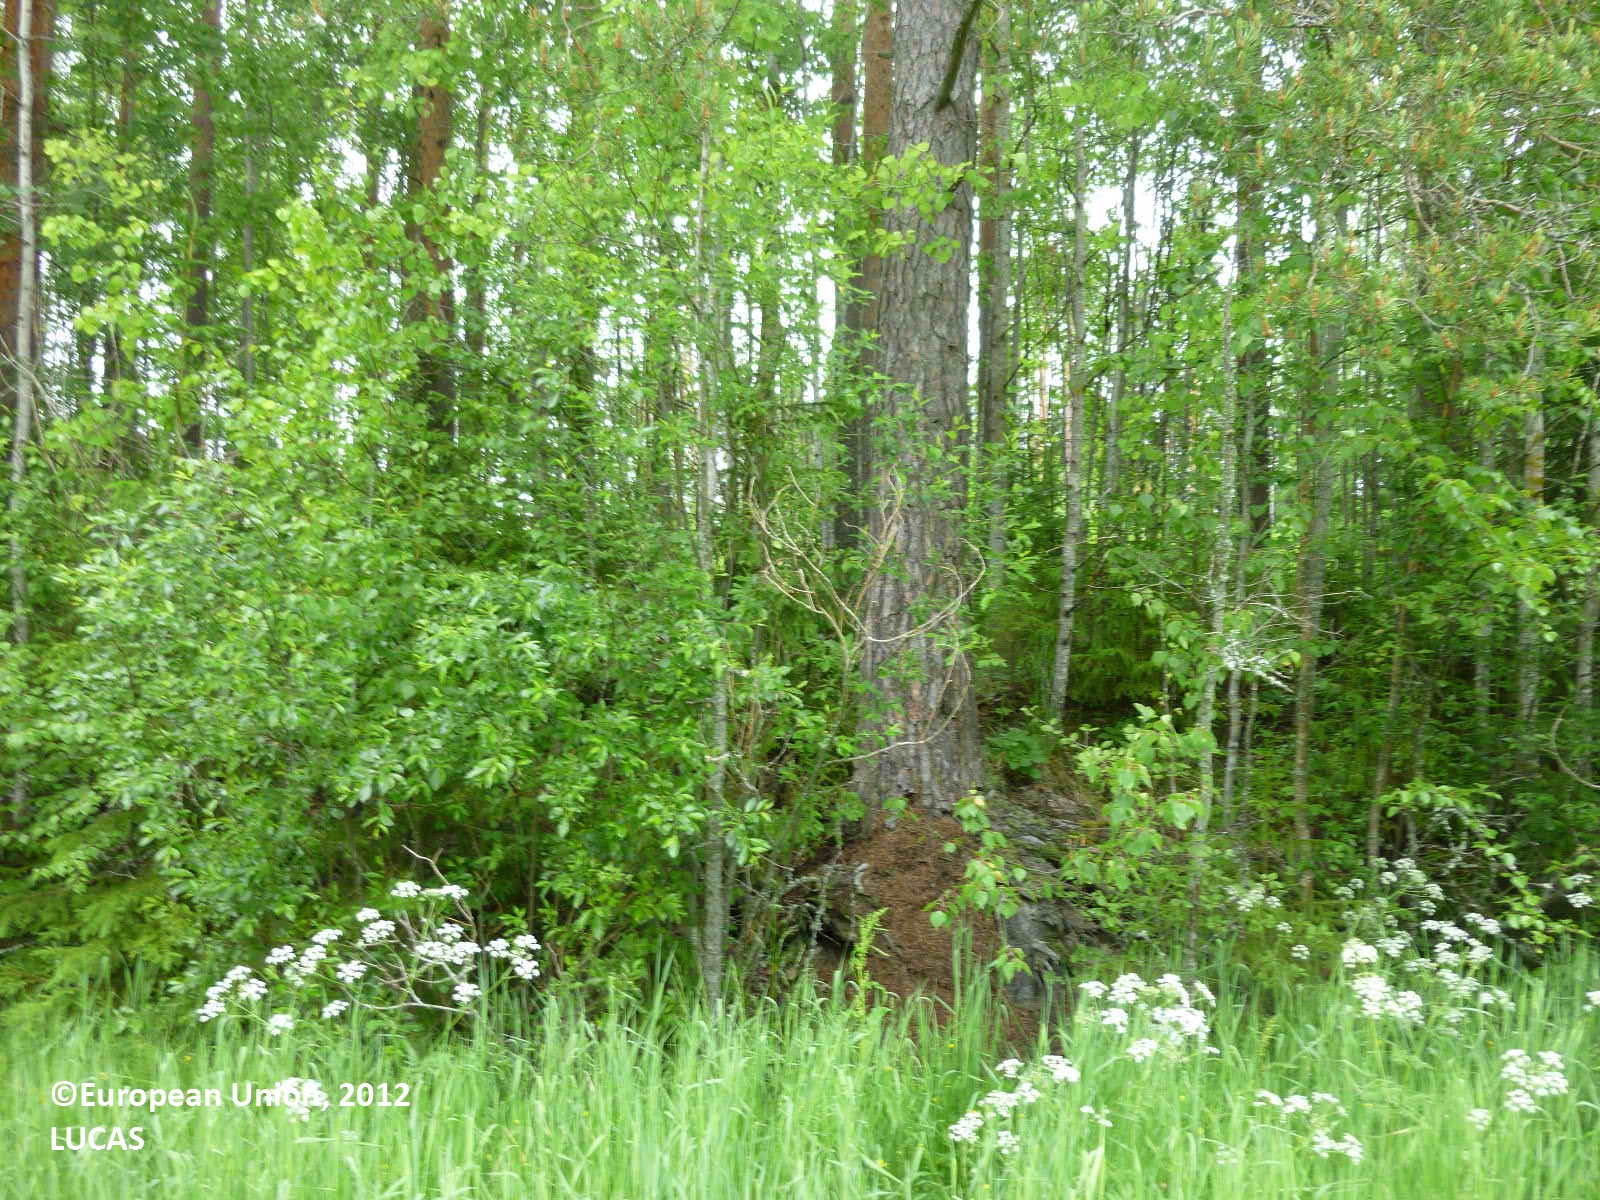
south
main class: Grassland
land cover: Grassland without tree/shrub cover
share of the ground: > 75 %
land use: Fallow land
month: June
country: FI
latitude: 61.6530
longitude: 22.4656
